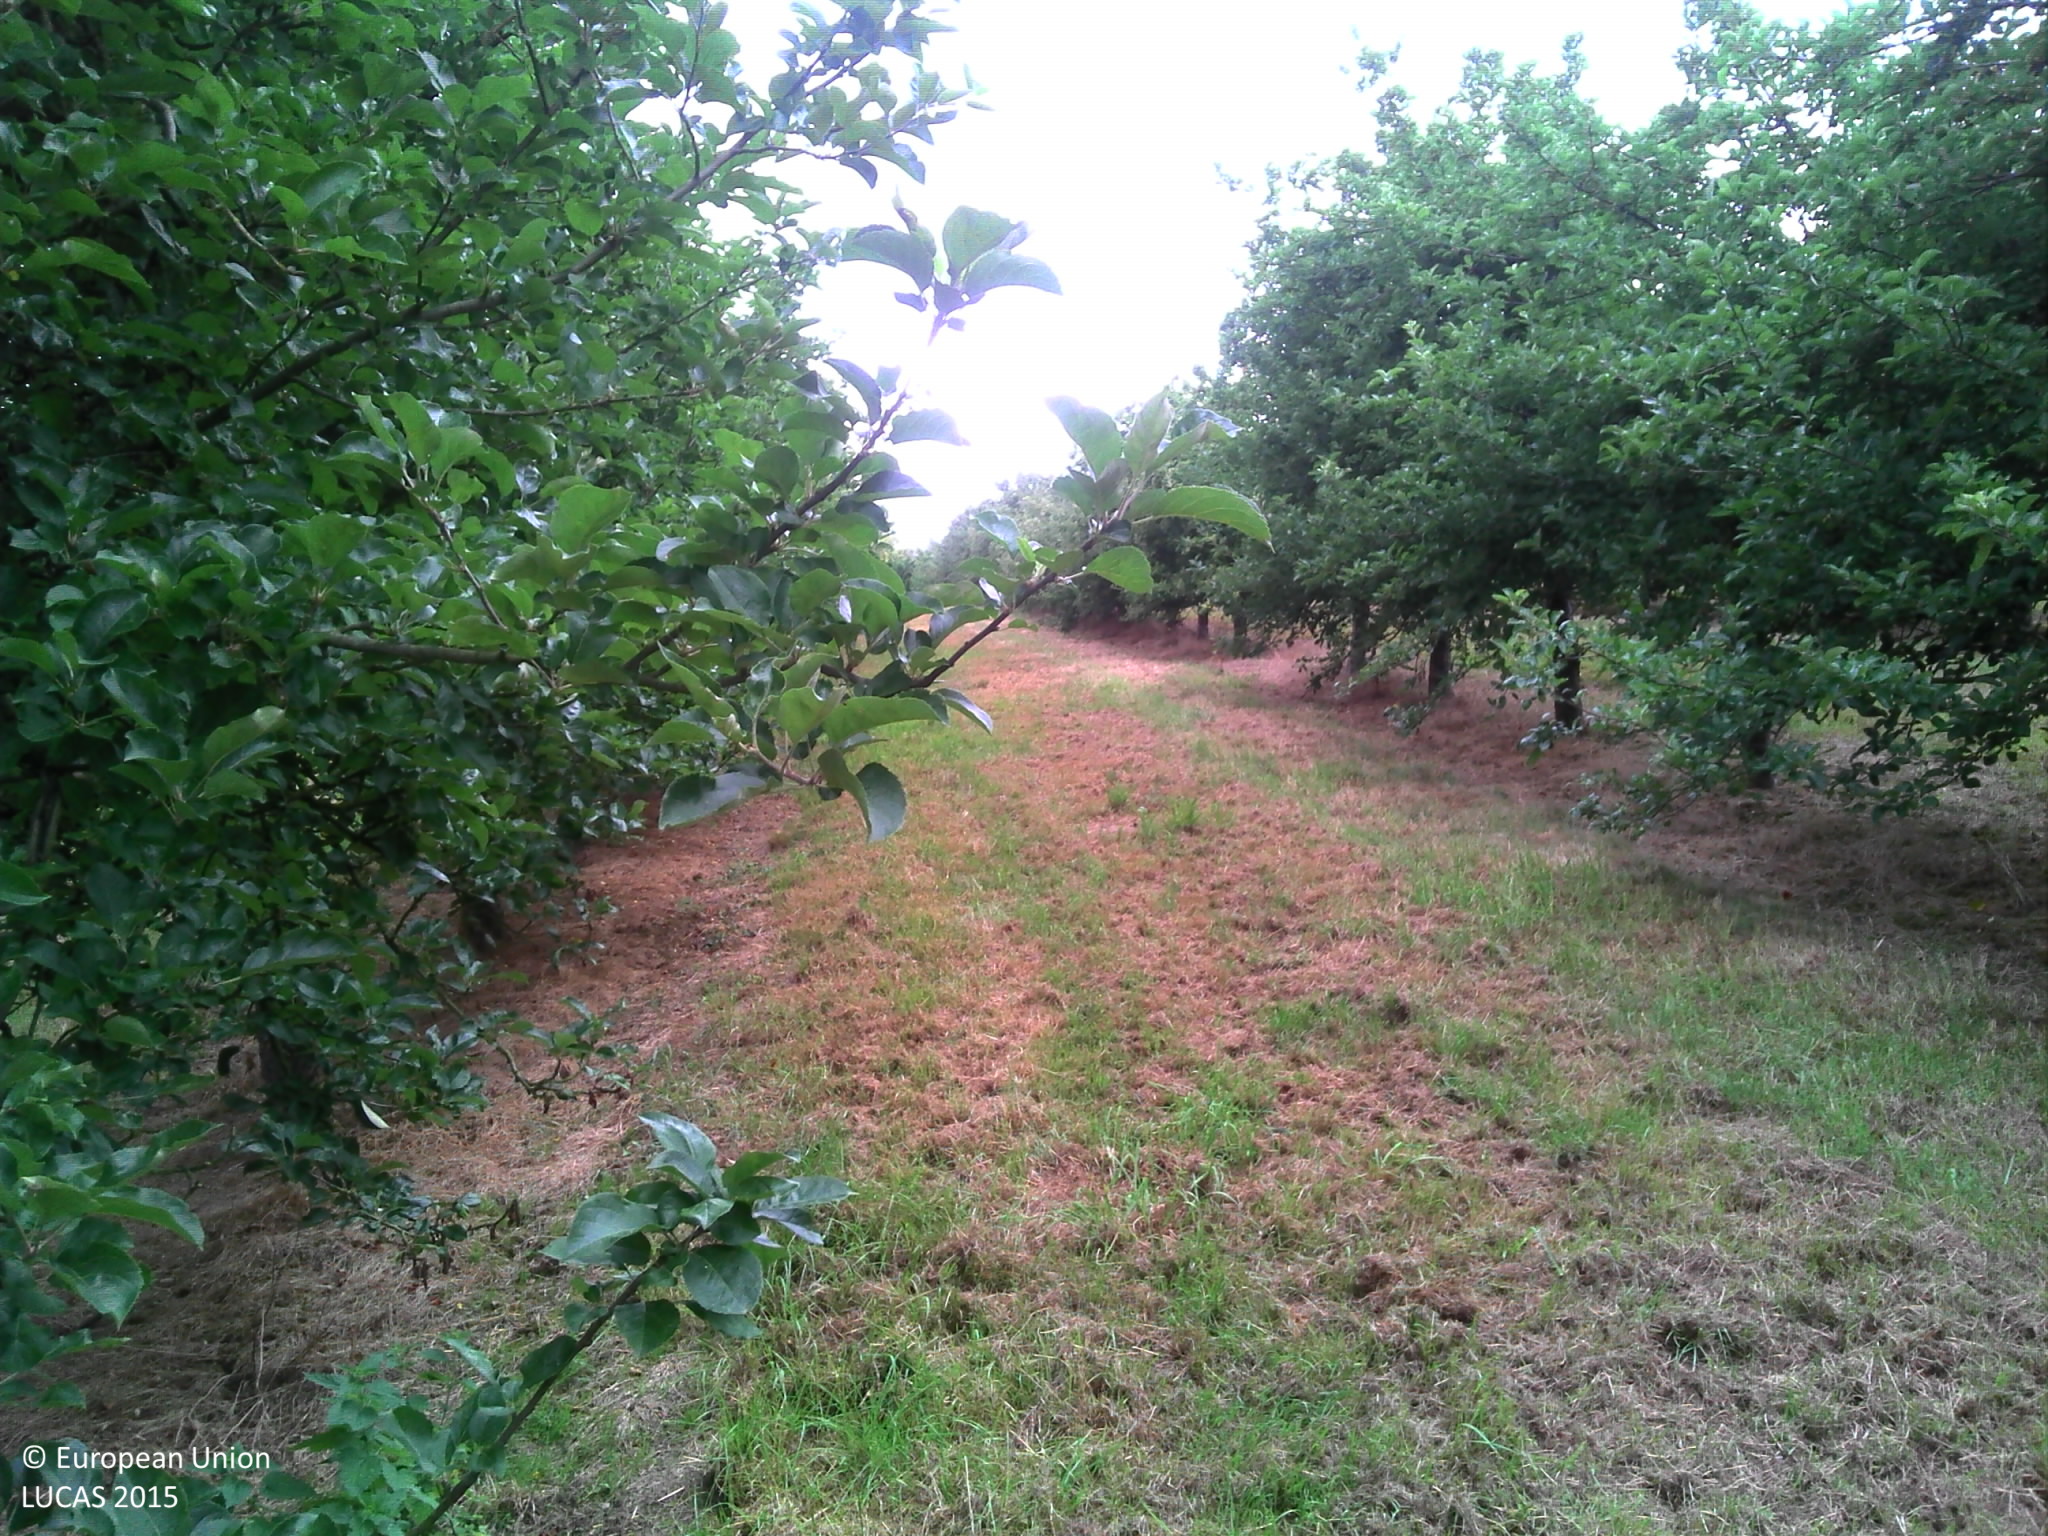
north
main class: Cropland
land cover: Apple fruit
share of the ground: 25 - 50 %
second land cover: Grassland without tree/shrub cover
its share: 50 - 75 %
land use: Agriculture (excluding fallow land and kitchen gardens)
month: July
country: FR
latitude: 48.5606
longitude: -2.2117
